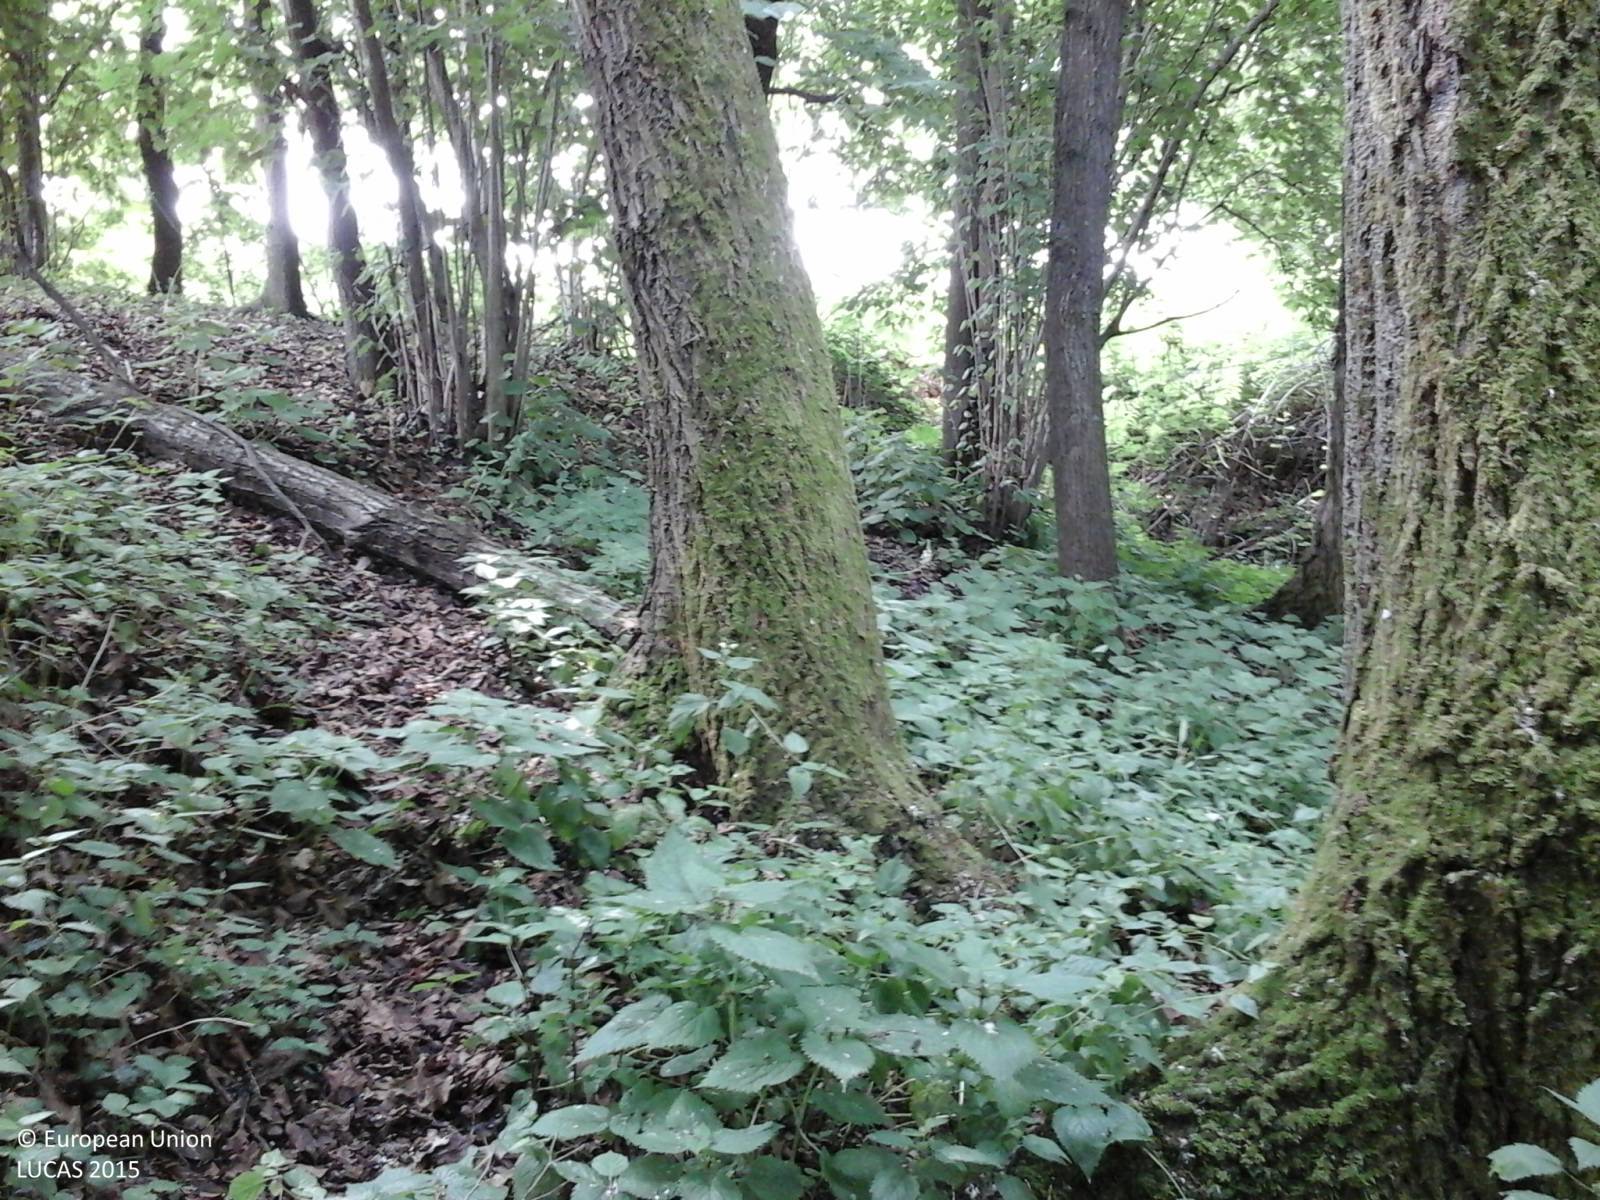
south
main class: Woodland
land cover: Broadleaved woodland
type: thermophilous deciduous forest
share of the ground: > 75 %
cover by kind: broadleaved forest trees 80 %, shrubs 20 %
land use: Forestry
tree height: > 5 m
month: May
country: IT
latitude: 45.8698
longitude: 13.2296
